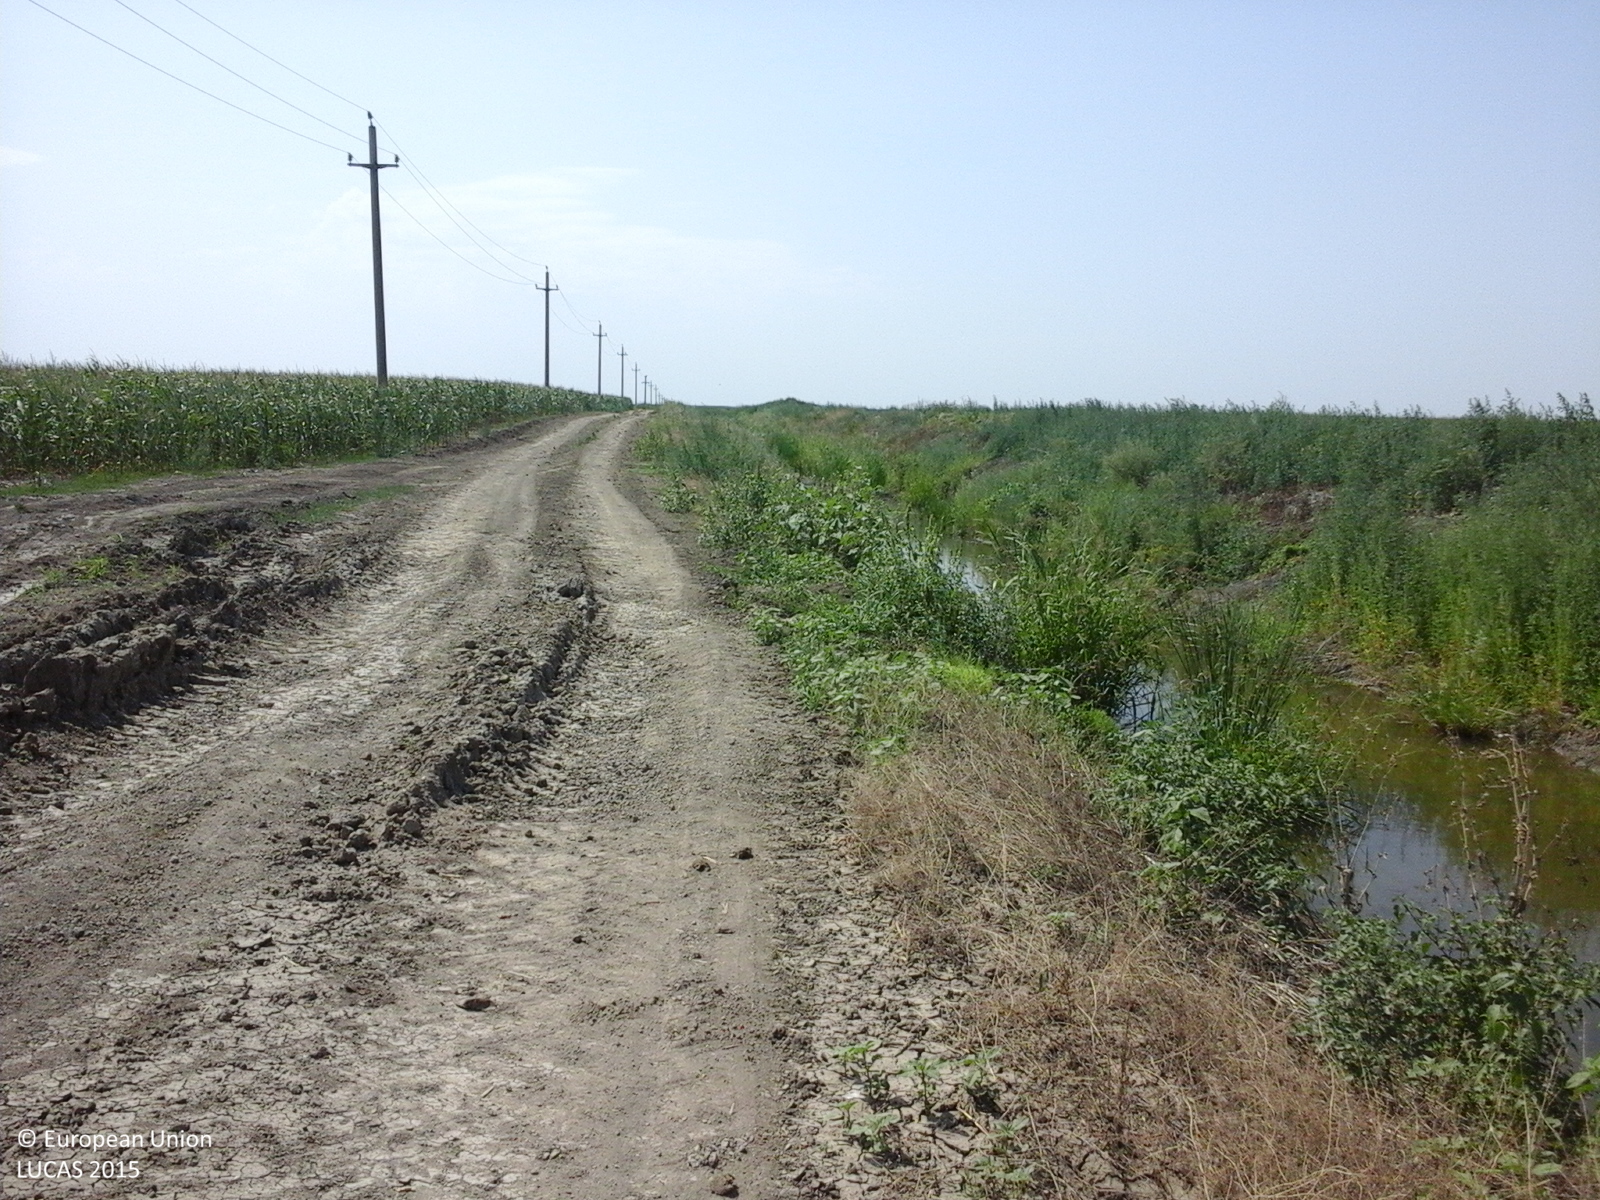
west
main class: Cropland
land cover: Soya
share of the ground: > 75 %
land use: Agriculture (excluding fallow land and kitchen gardens)
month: August
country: RO
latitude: 45.0122
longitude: 27.9908
